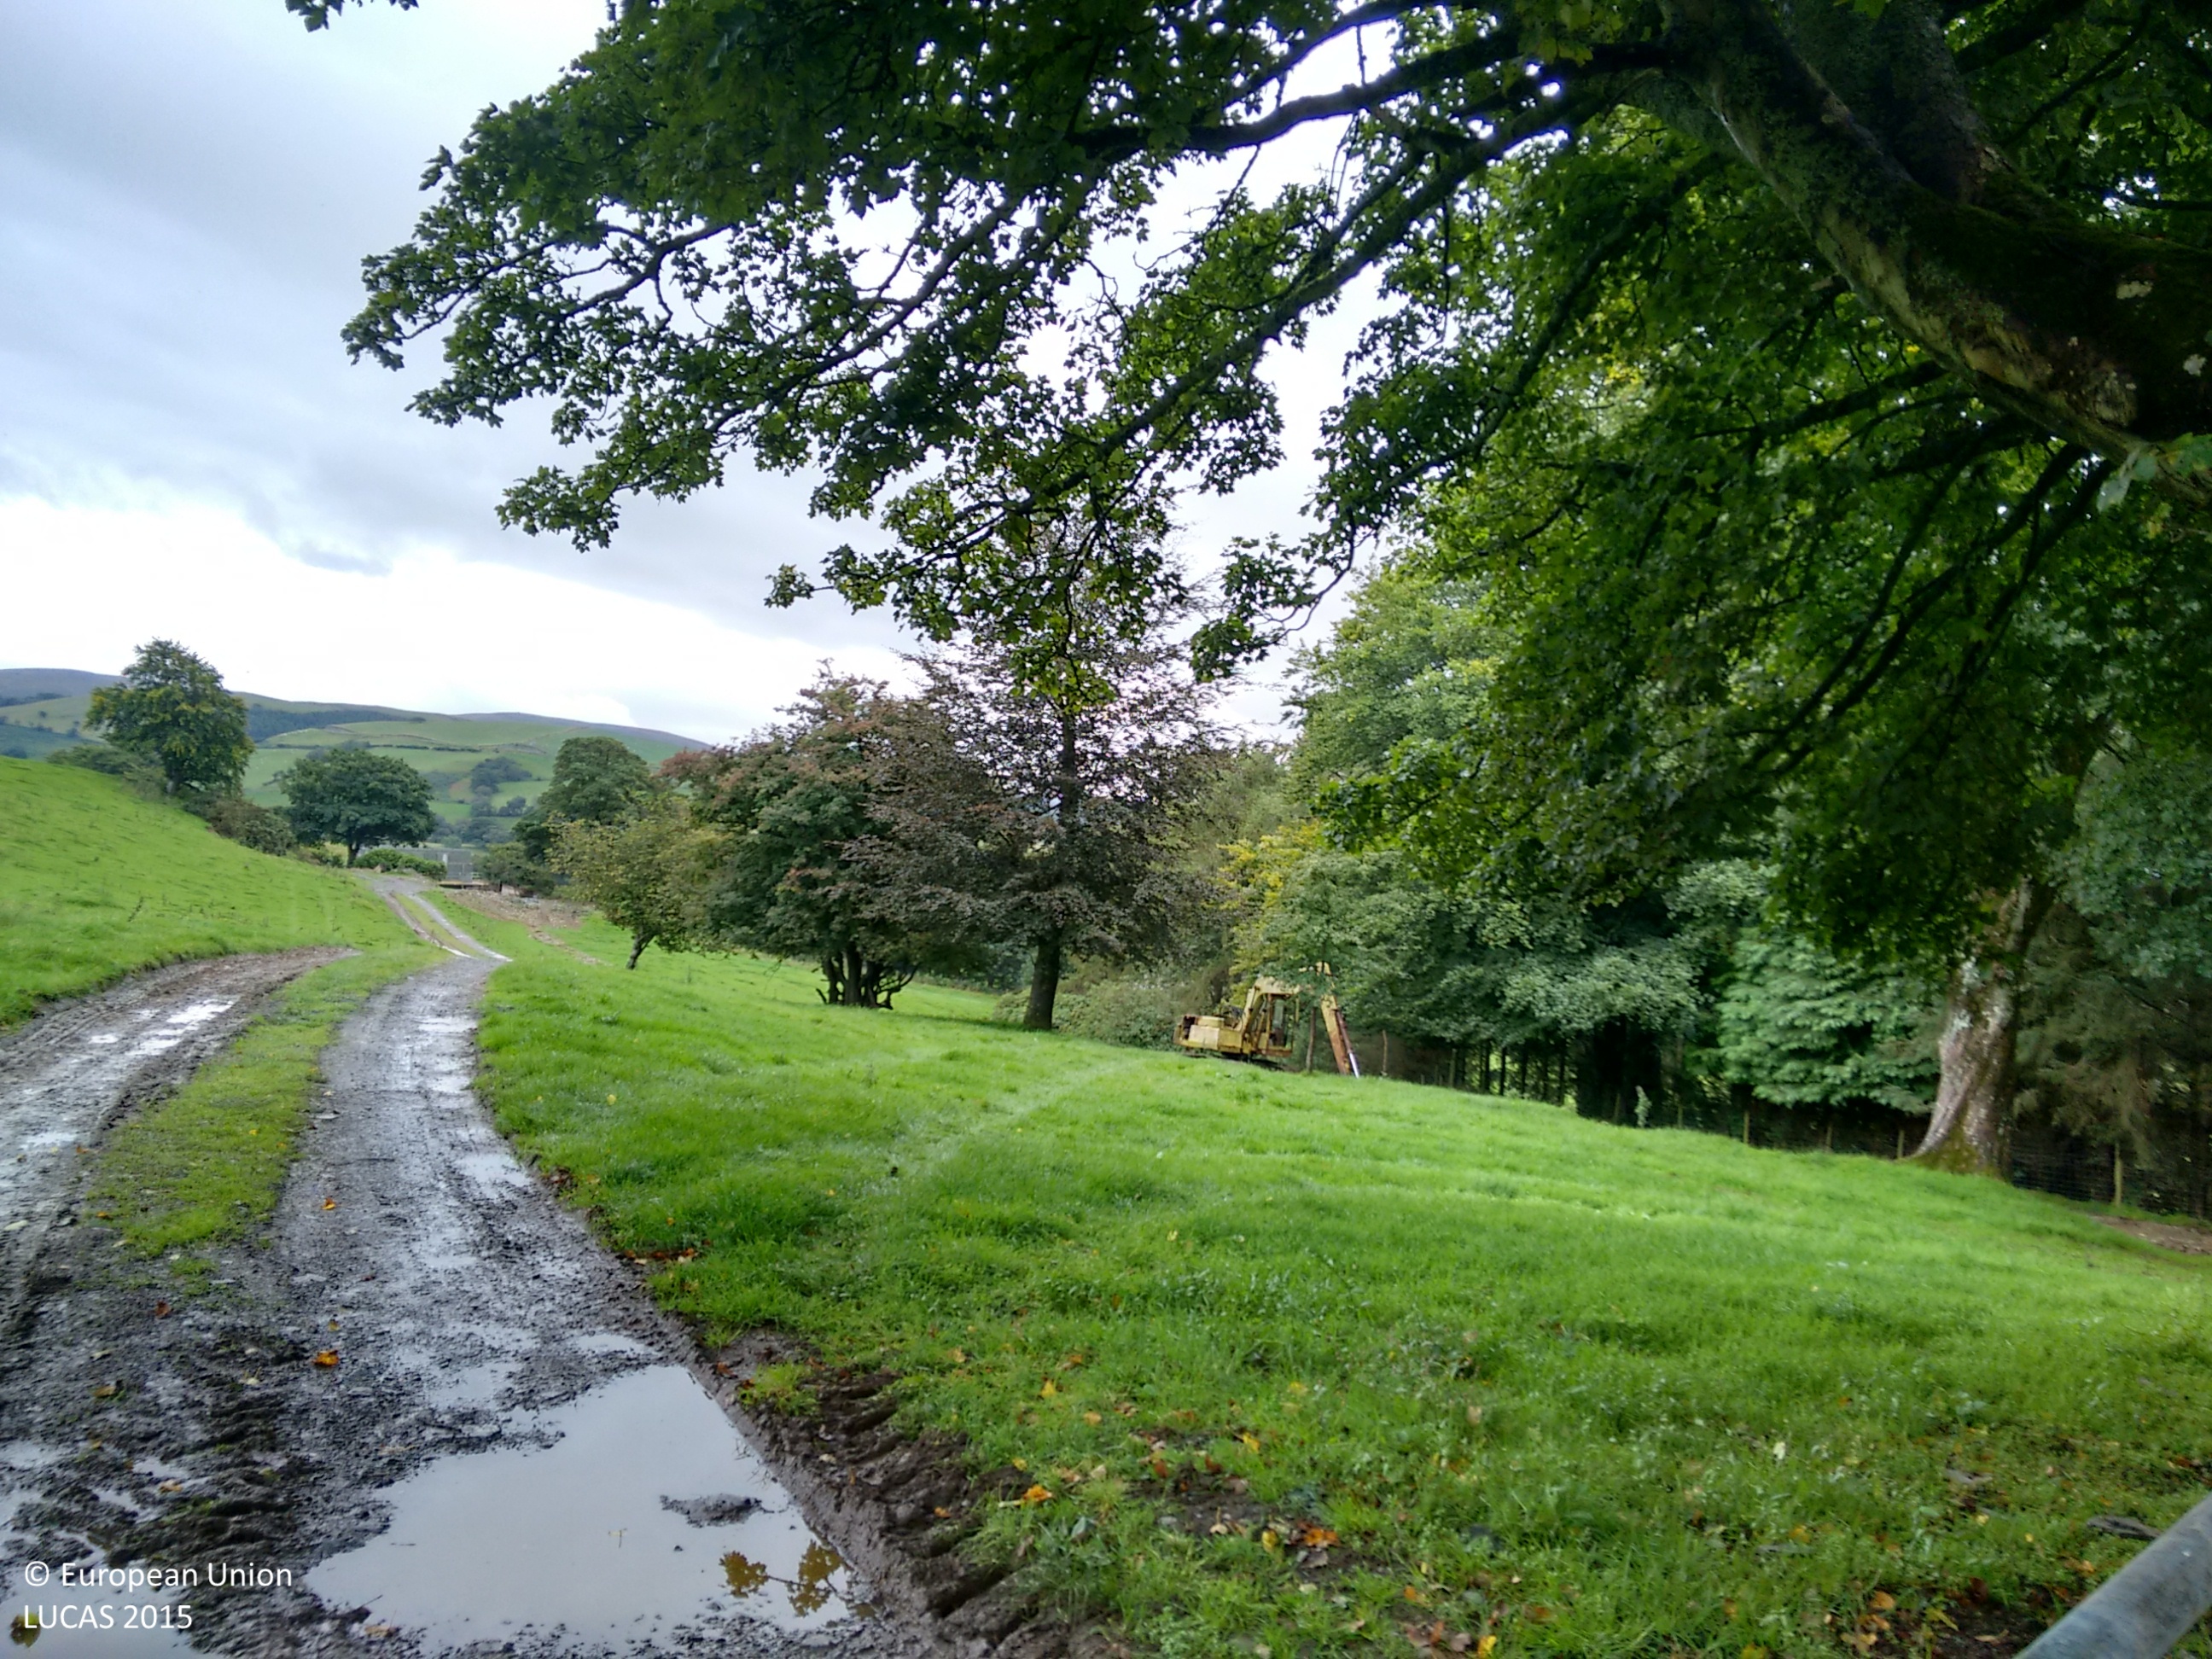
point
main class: Woodland
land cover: Broadleaved woodland
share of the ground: > 75 %
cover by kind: broadleaved forest trees 60 %, herbaceous plants 40 %
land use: Agriculture (excluding fallow land and kitchen gardens)
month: September
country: GB
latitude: 52.2265
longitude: -3.9278
